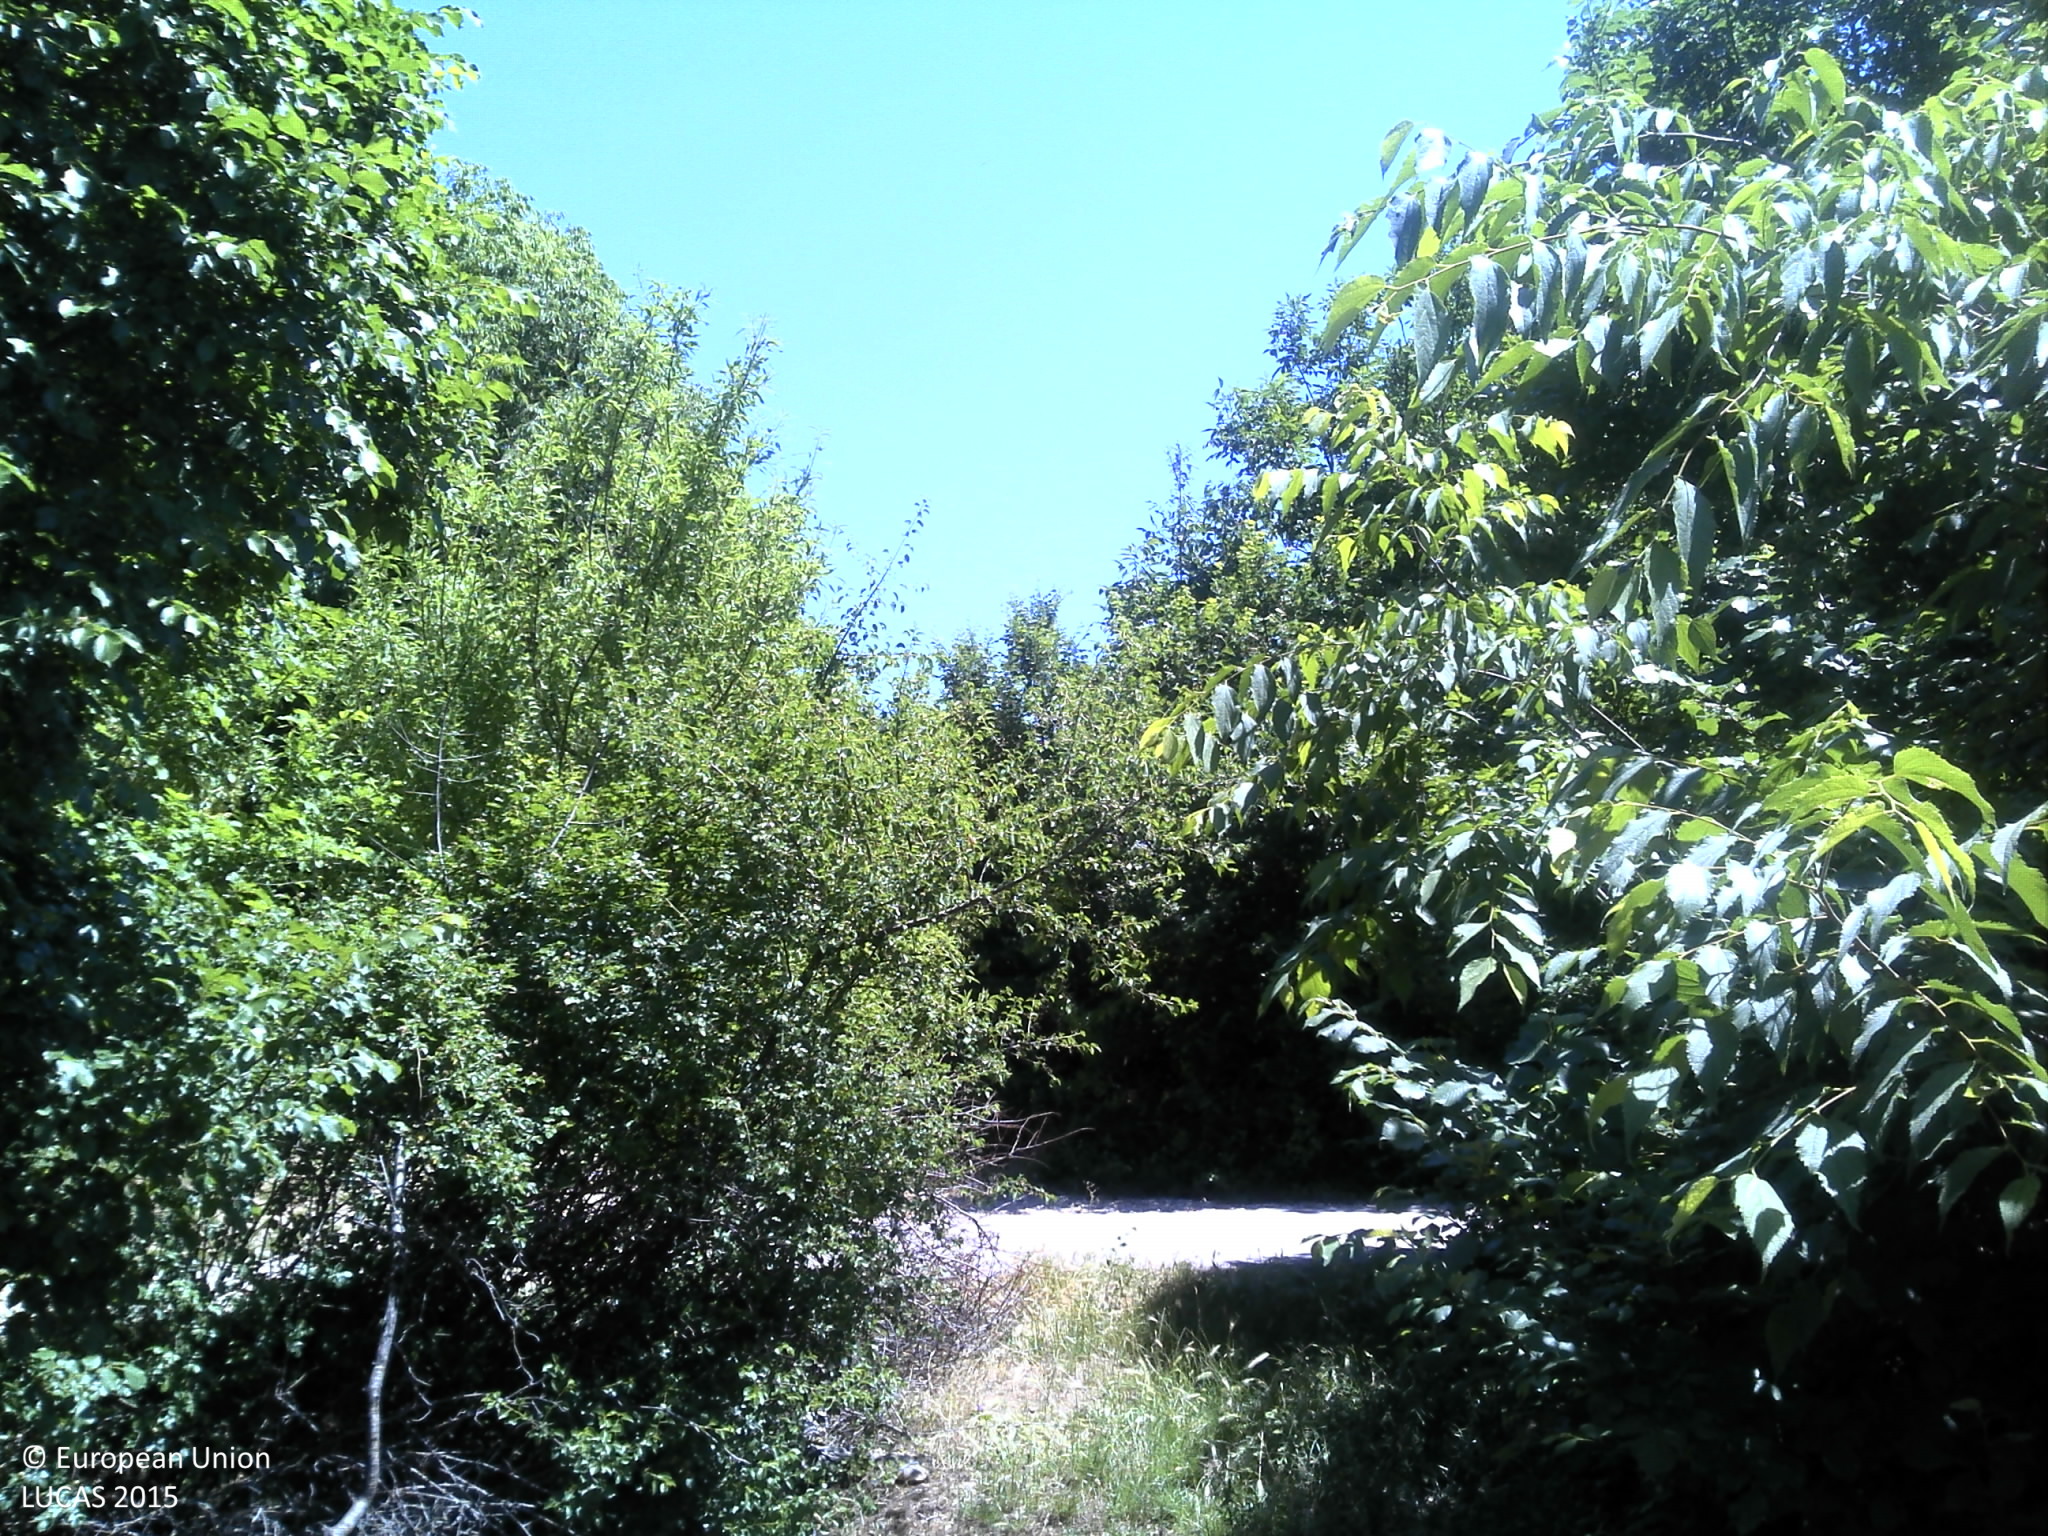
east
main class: Woodland
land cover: Broadleaved woodland
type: thermophilous deciduous forest
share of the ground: 25 - 50 %
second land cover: Grassland without tree/shrub cover
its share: 50 - 75 %
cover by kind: herbaceous plants 50 %, broadleaved forest trees 30 %, shrubs 20 %
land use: Forestry
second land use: Agriculture (excluding fallow land and kitchen gardens)
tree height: > 5 m
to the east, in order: Broadleaved woodland; Grassland without tree/shrub cover; Paved roads, cycling and walking lanes; Shrubland with sparse tree cover; Dry stone walls; Shrubland with sparse tree cover; Other fresh vegetables; Fences; Grassland with sparse tree/shrub cover; Fences; Dry stone walls; Grassland with sparse tree/shrub cover; Dry stone walls; Paved roads, cycling and walking lanes; Dry stone walls; Electric lines; Shrubland with sparse tree cover; Dry stone walls; Shrubland with sparse tree cover; Dry stone walls; Shrubland with sparse tree cover
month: May
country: HR
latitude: 43.9160
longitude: 16.1315
